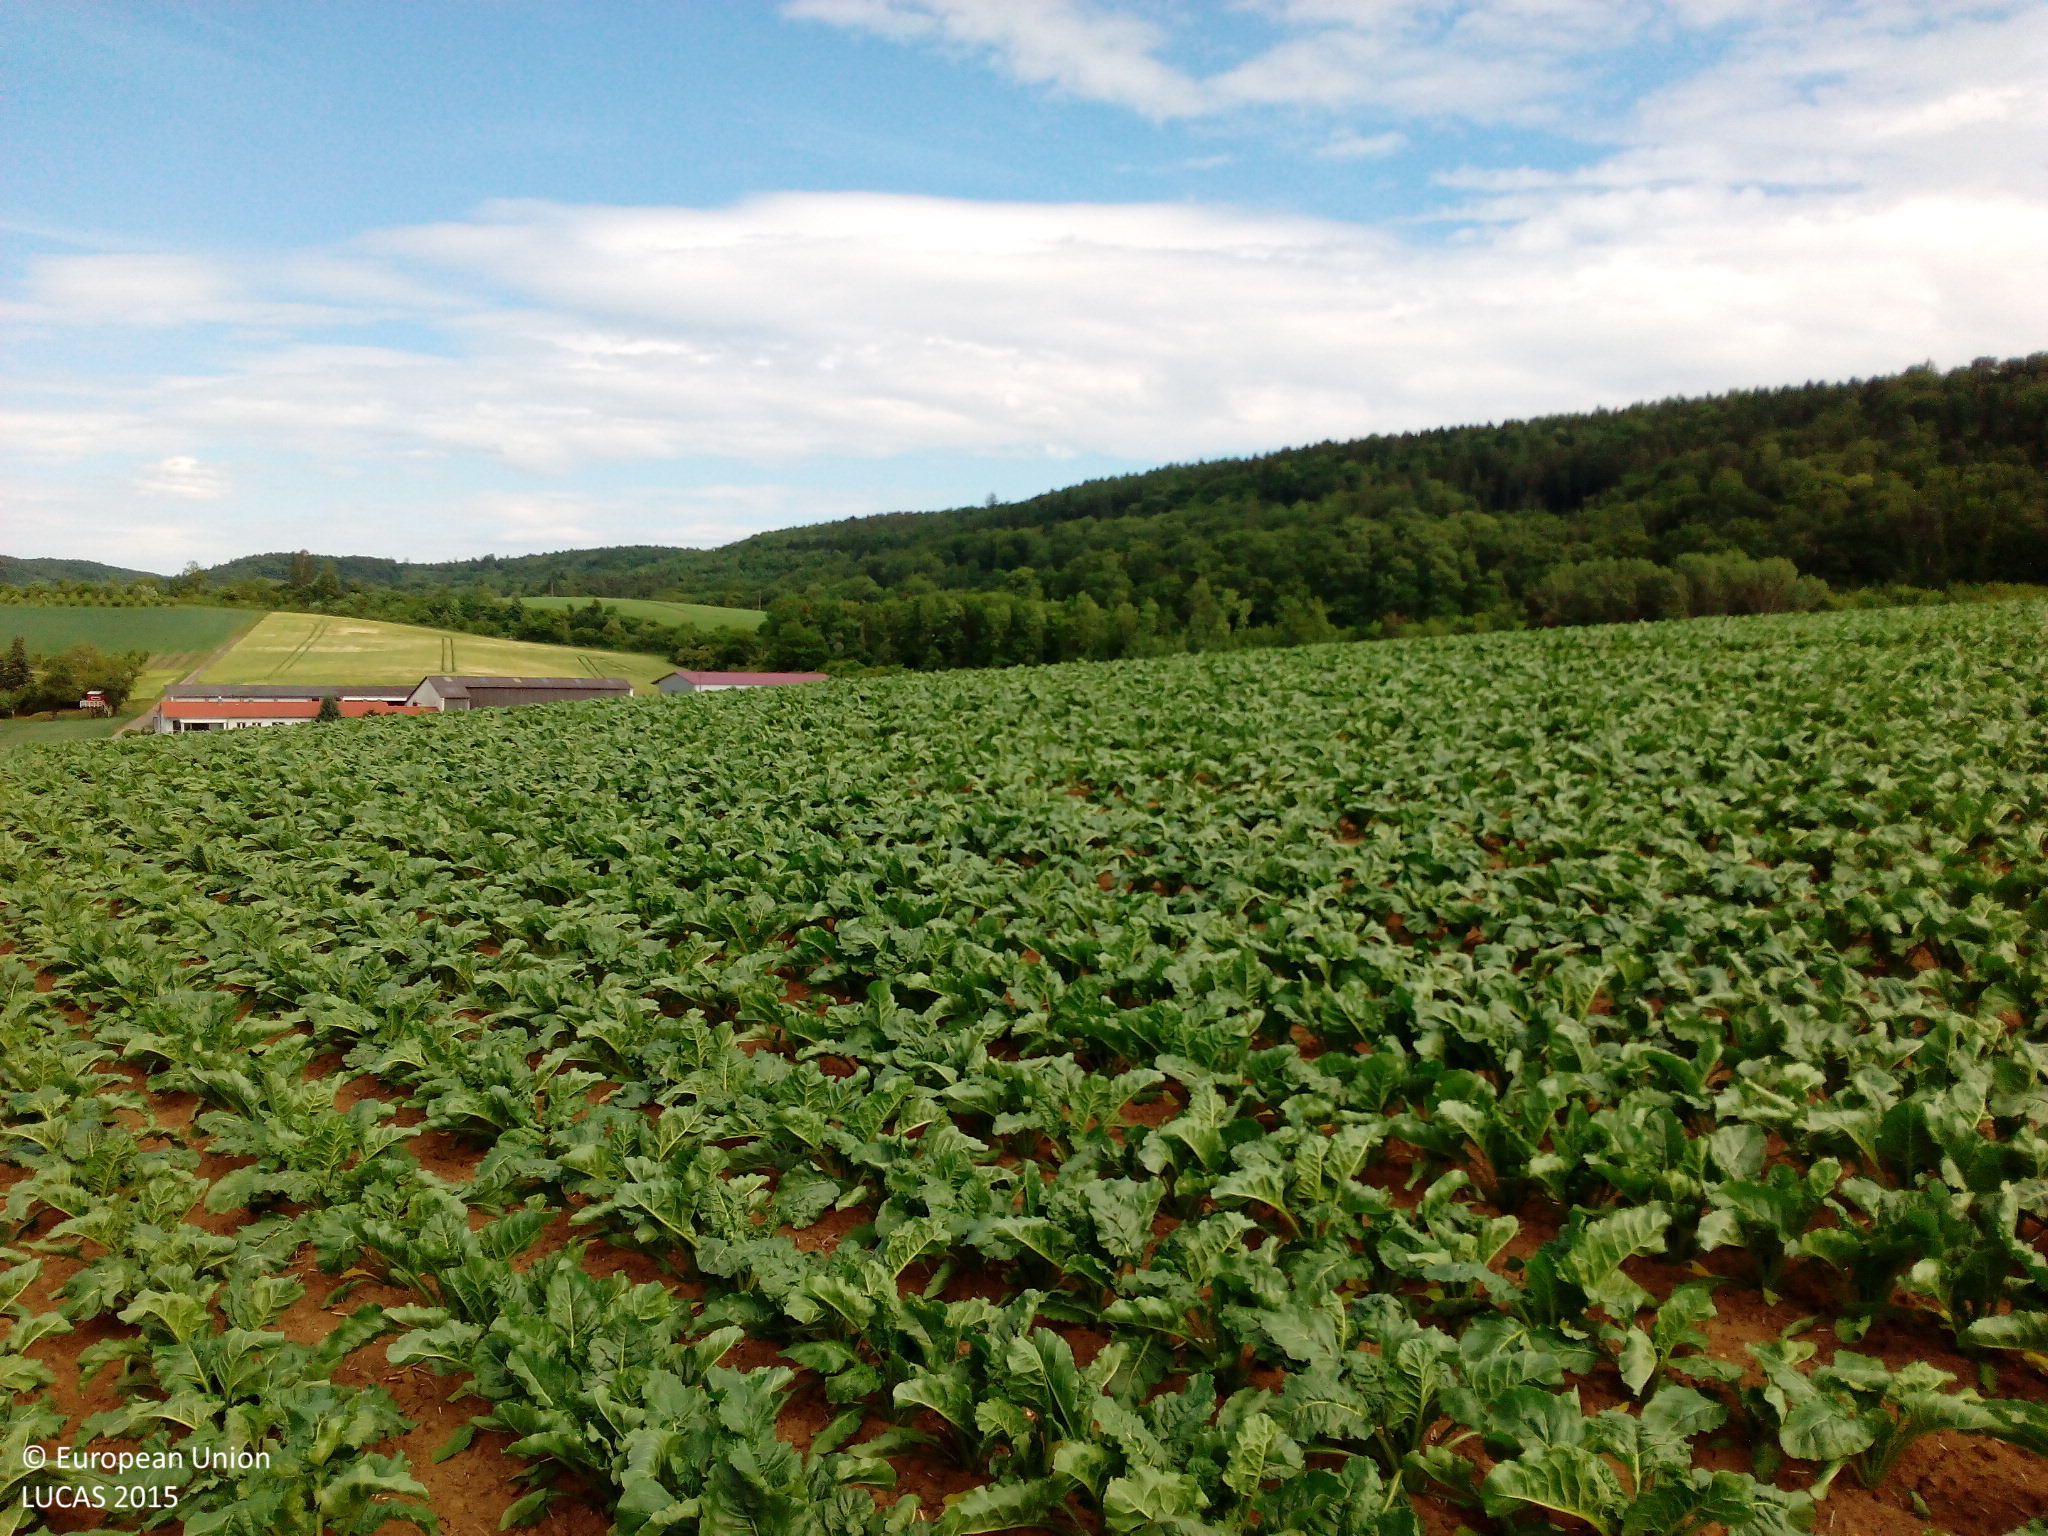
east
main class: Cropland
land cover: Sugar beet
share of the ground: > 75 %
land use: Agriculture (excluding fallow land and kitchen gardens)
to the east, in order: Sugar beet; Grass margins; Paved roads, cycling and walking lanes
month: June
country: DE
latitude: 49.1751
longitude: 9.3281
